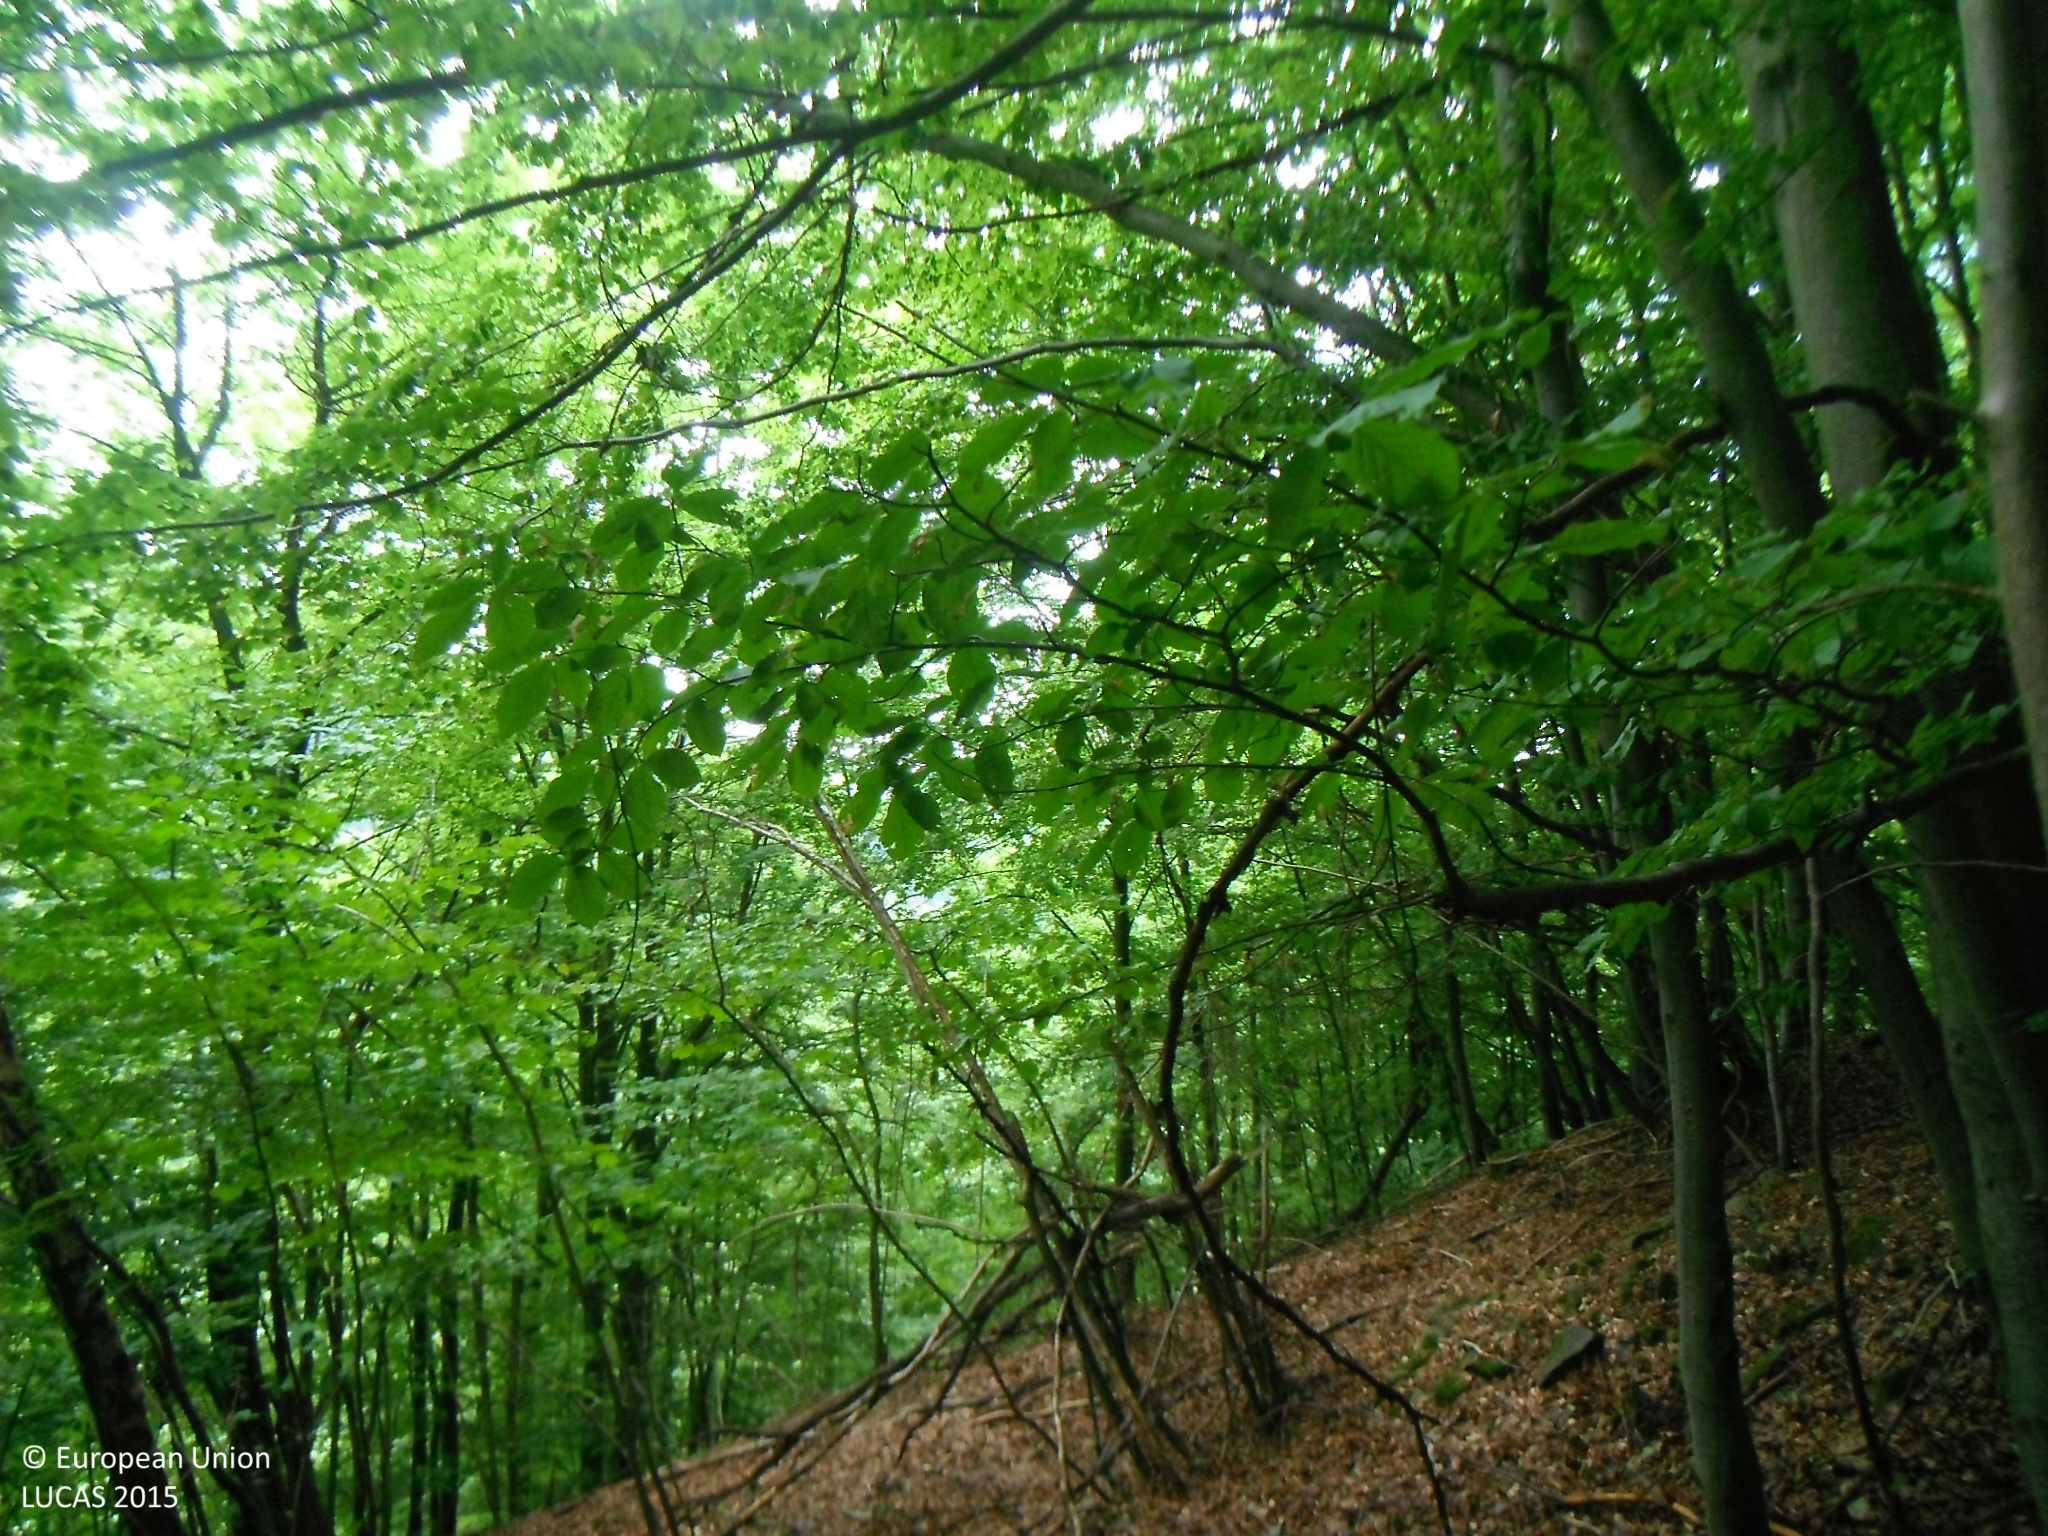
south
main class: Woodland
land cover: Broadleaved woodland
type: mountainous beech forest
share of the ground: > 75 %
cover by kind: broadleaved forest trees 95 %, unconsolidated bare surface 5 %
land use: Forestry
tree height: > 5 m
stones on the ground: > 50 %
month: July
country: SK
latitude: 49.2663
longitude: 18.3035
